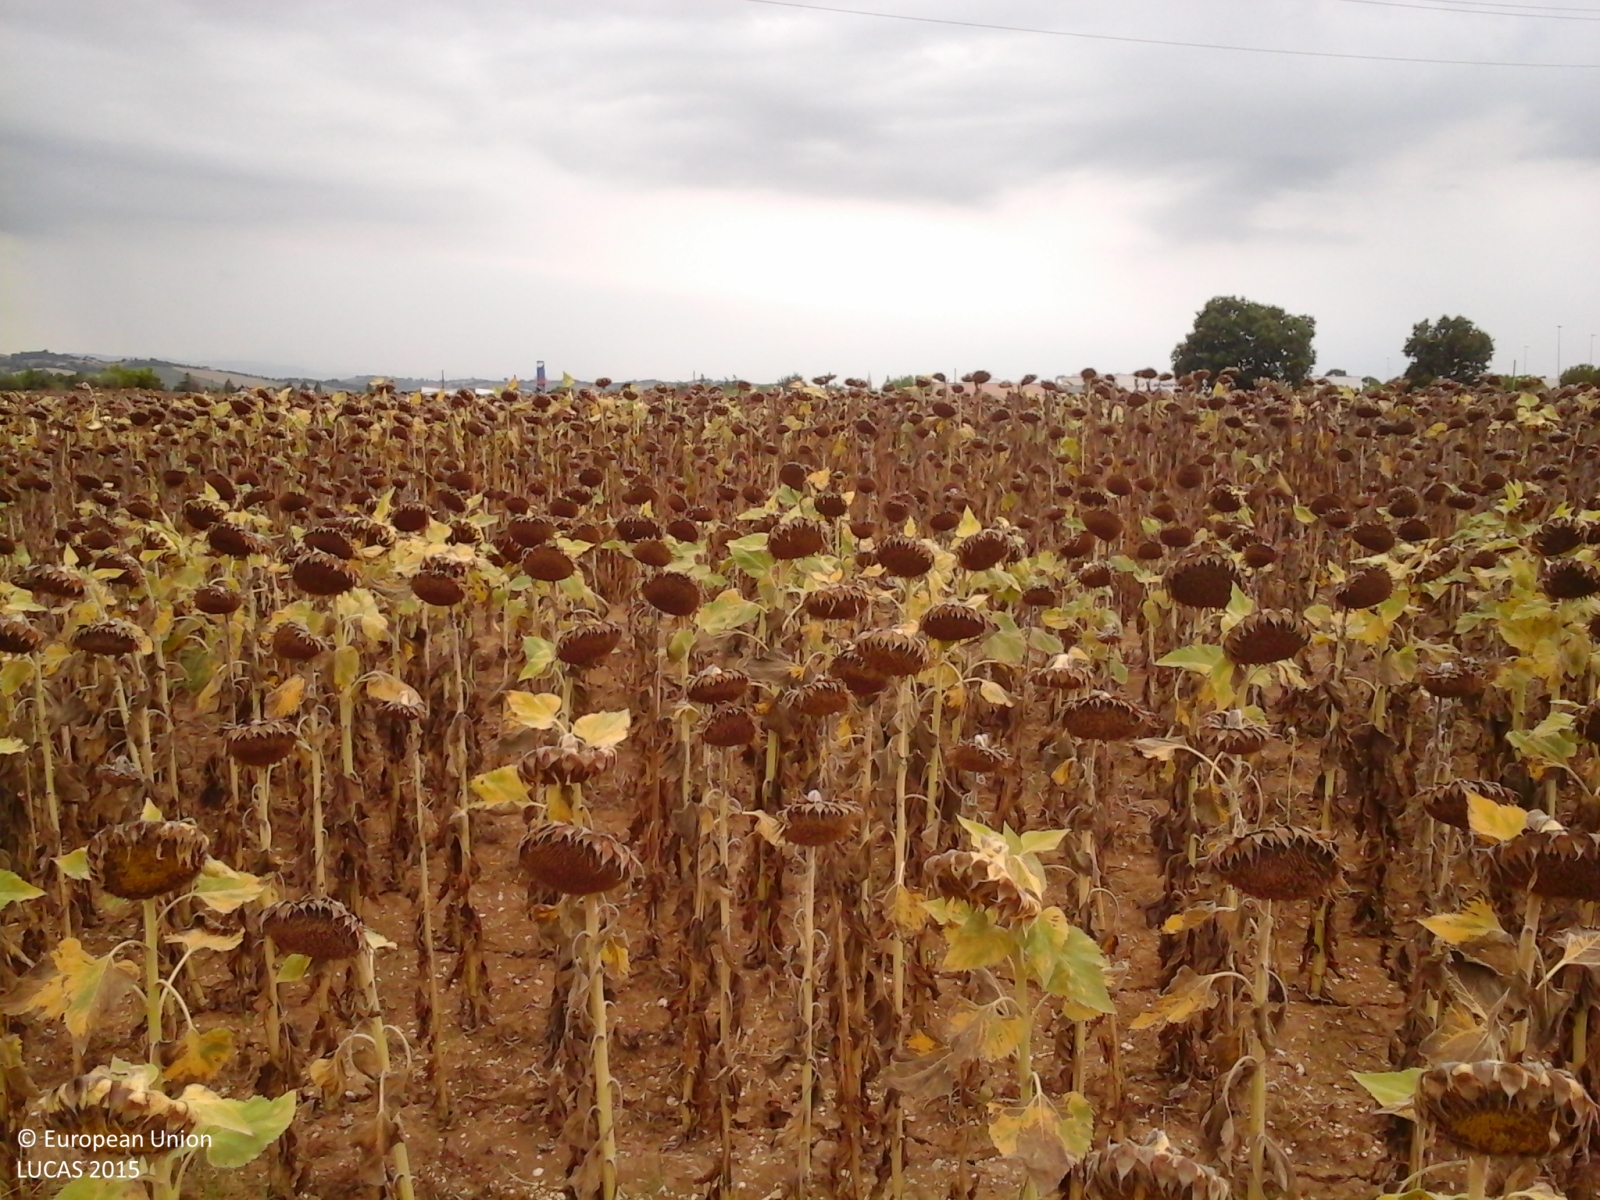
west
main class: Cropland
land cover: Sunflower
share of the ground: > 75 %
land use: Agriculture (excluding fallow land and kitchen gardens)
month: August
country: IT
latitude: 43.4604
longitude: 13.5138
